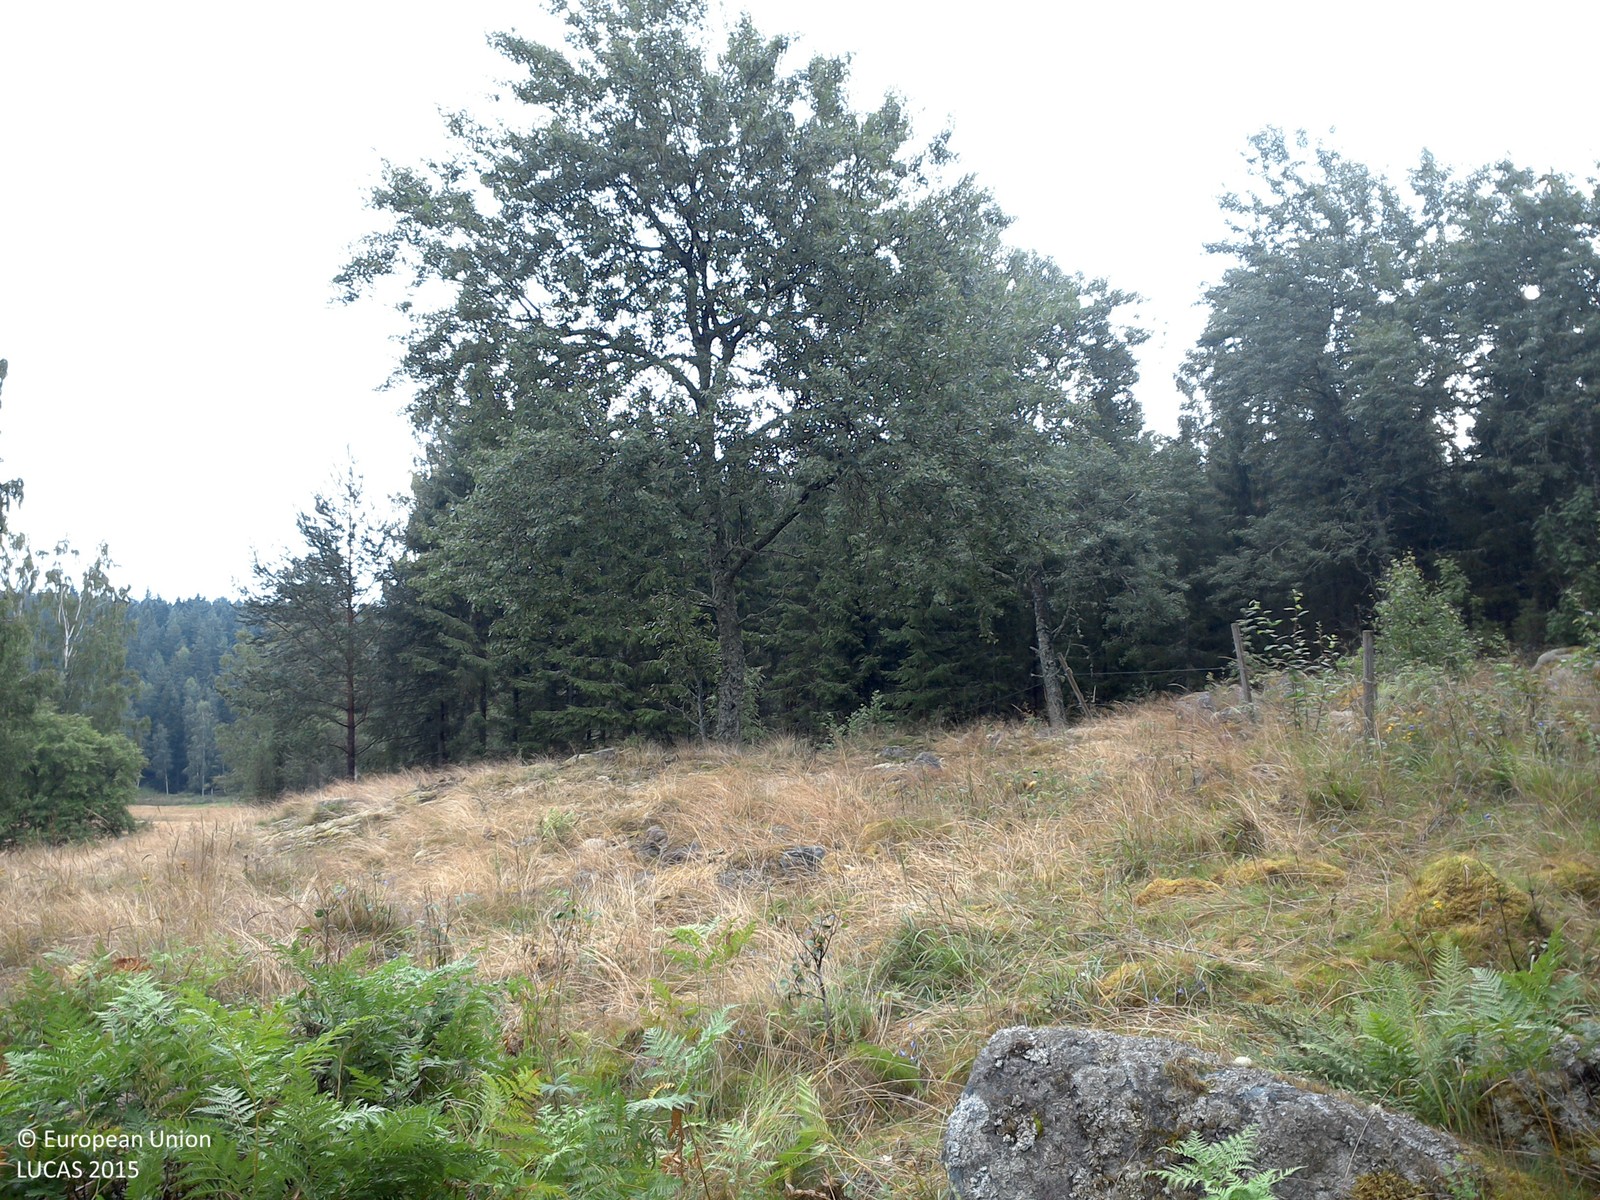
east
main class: Grassland
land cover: Grassland with sparse tree/shrub cover
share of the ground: > 75 %
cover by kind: herbaceous plants 90 %, broadleaved forest trees 5 %, shrubs 5 %
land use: Agriculture (excluding fallow land and kitchen gardens)
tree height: > 5 m
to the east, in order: Grassland with sparse tree/shrub cover; Fences; Grassland with sparse tree/shrub cover; Spruce dominated coniferous woodland; Fences; Tracks; Grassland with sparse tree/shrub cover; Fences; Broadleaved woodland; Rivers and streams; Broadleaved woodland; Grassland without tree/shrub cover; Broadleaved woodland; Spruce dominated coniferous woodland
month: August
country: SE
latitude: 58.2141
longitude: 15.5268
